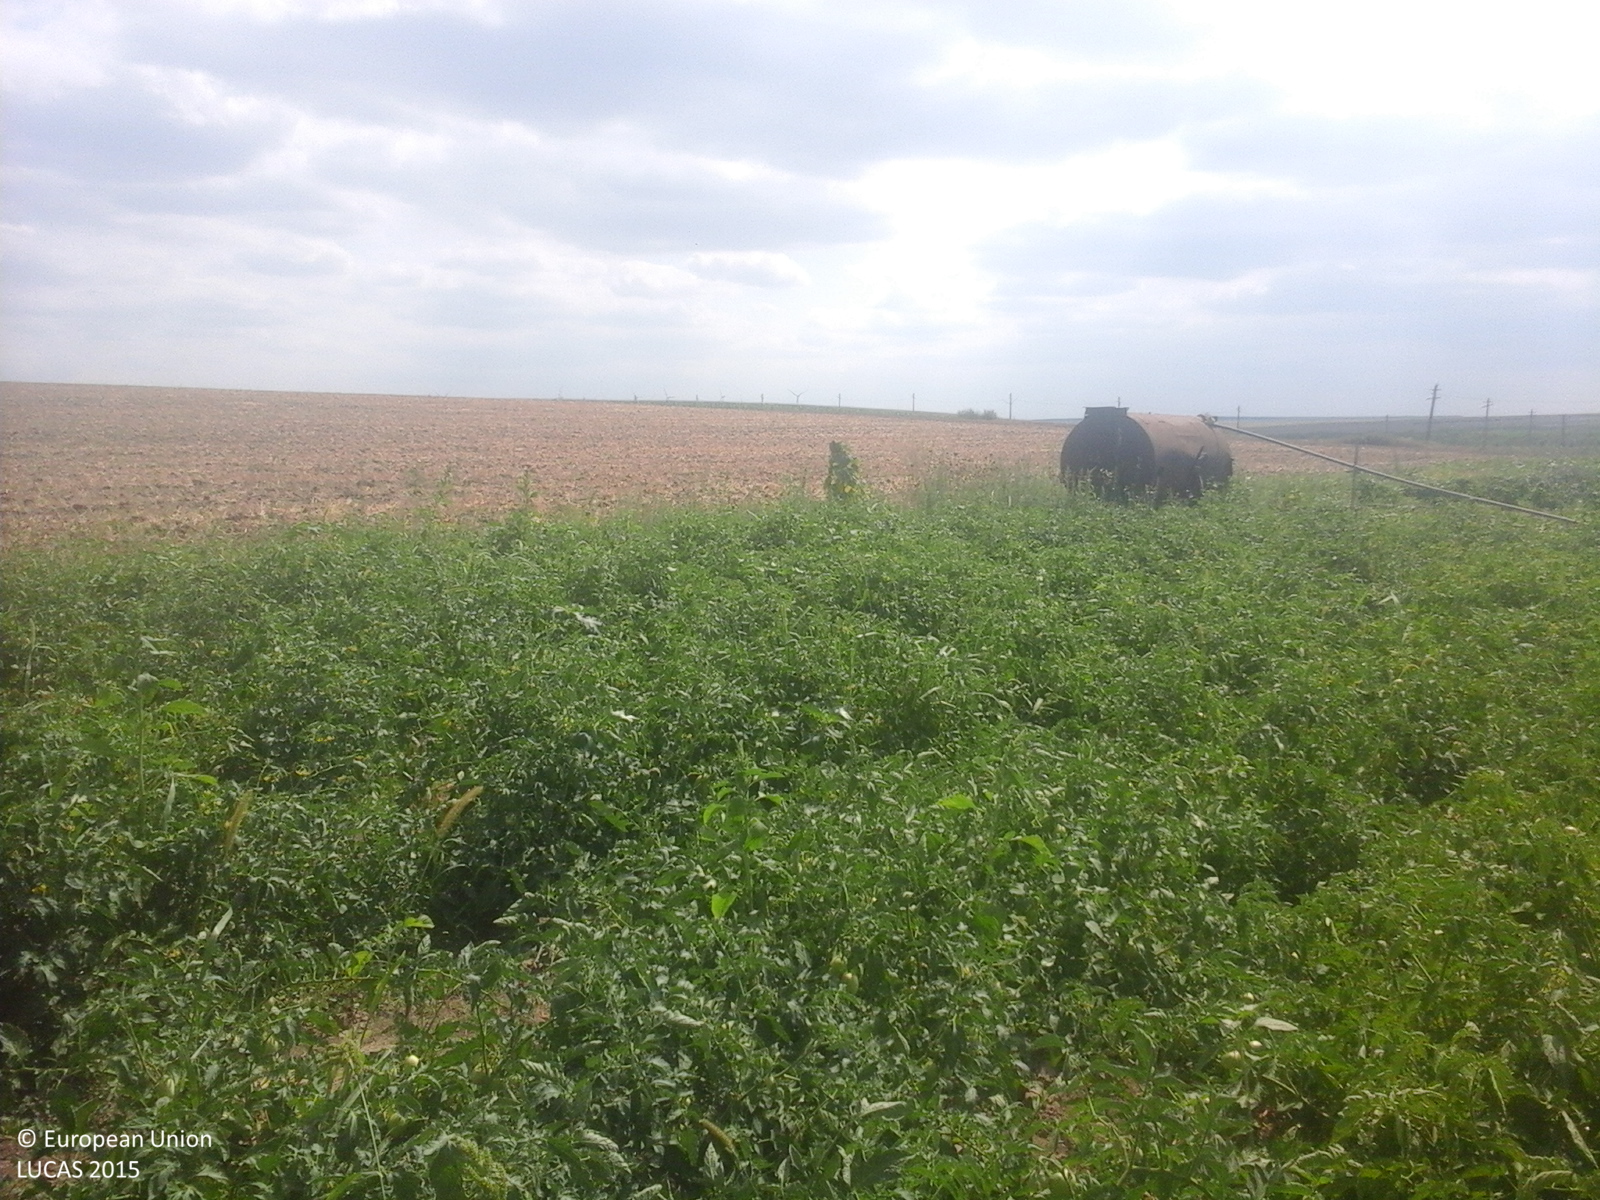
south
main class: Cropland
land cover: Tomatoes
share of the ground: > 75 %
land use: Agriculture (excluding fallow land and kitchen gardens)
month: August
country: RO
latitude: 44.6681
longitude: 28.2683
